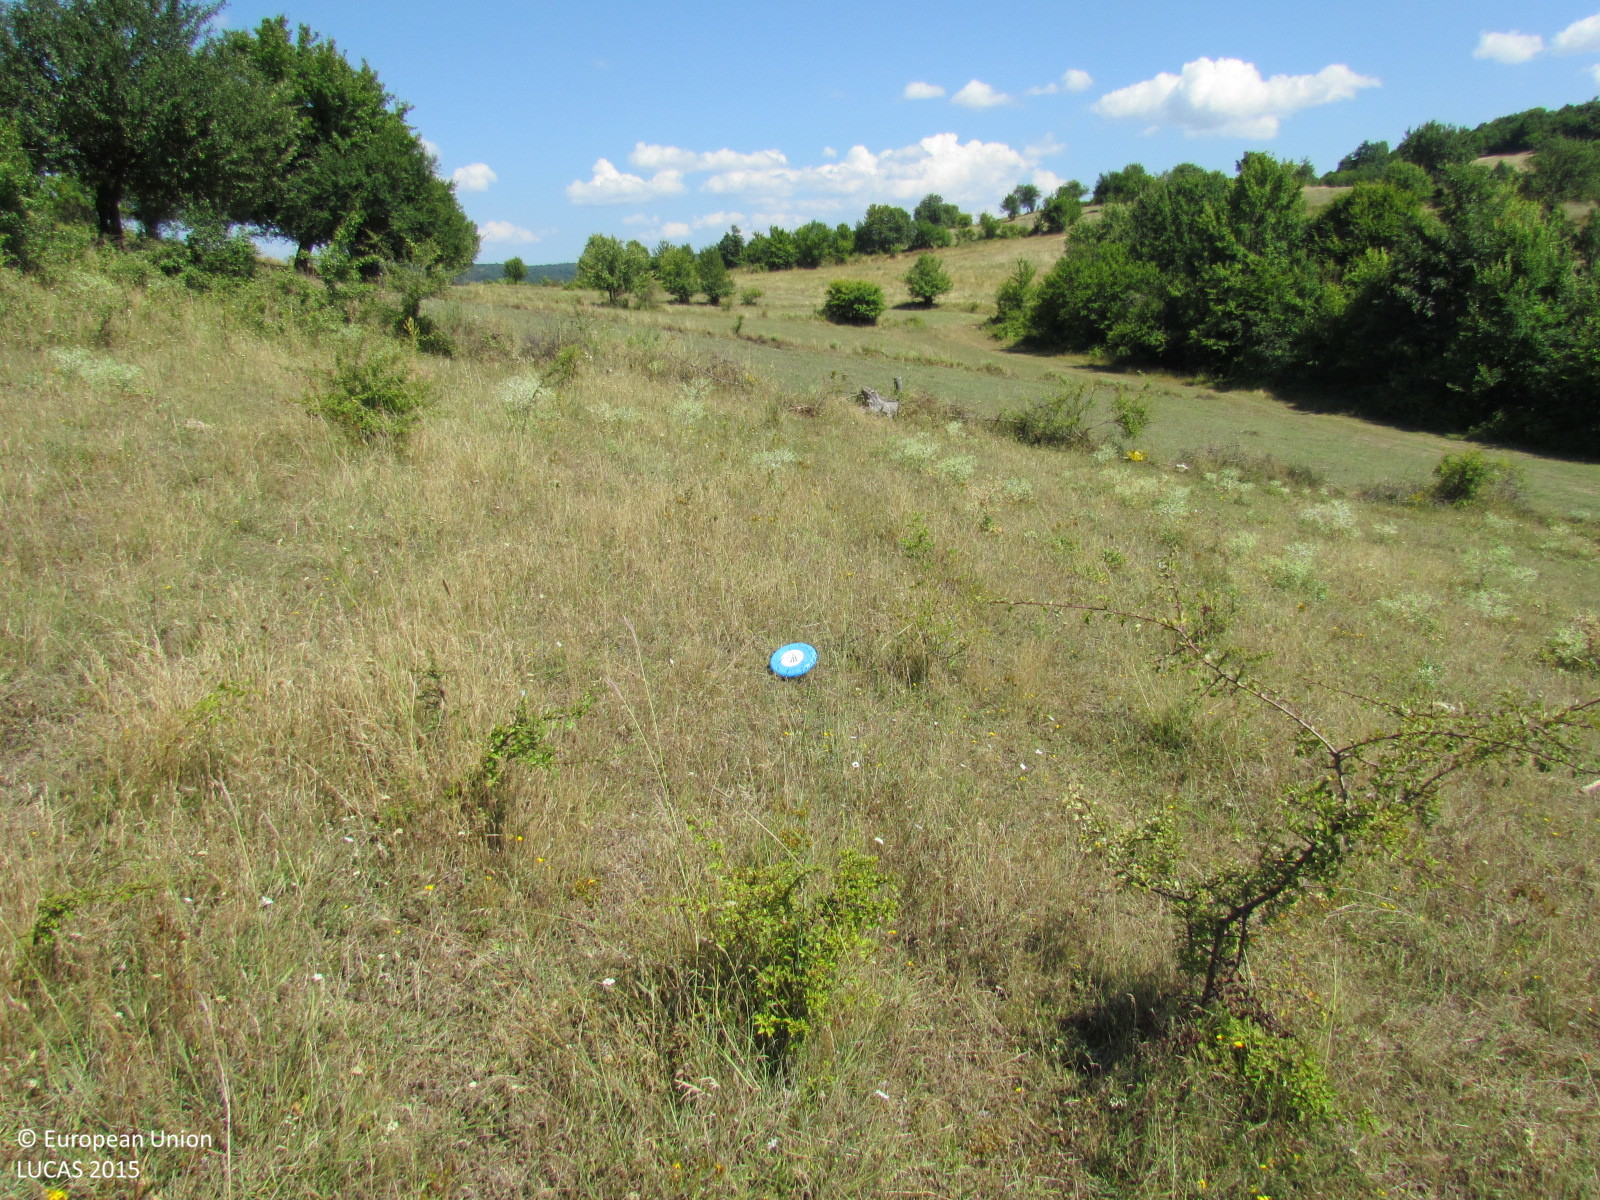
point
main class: Grassland
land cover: Grassland with sparse tree/shrub cover
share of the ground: > 75 %
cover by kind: herbaceous plants 85 %, shrubs 10 %, broadleaved forest trees 5 %
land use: Agriculture (excluding fallow land and kitchen gardens)
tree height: > 5 m
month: July
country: BG
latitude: 42.8773
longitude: 27.4444
